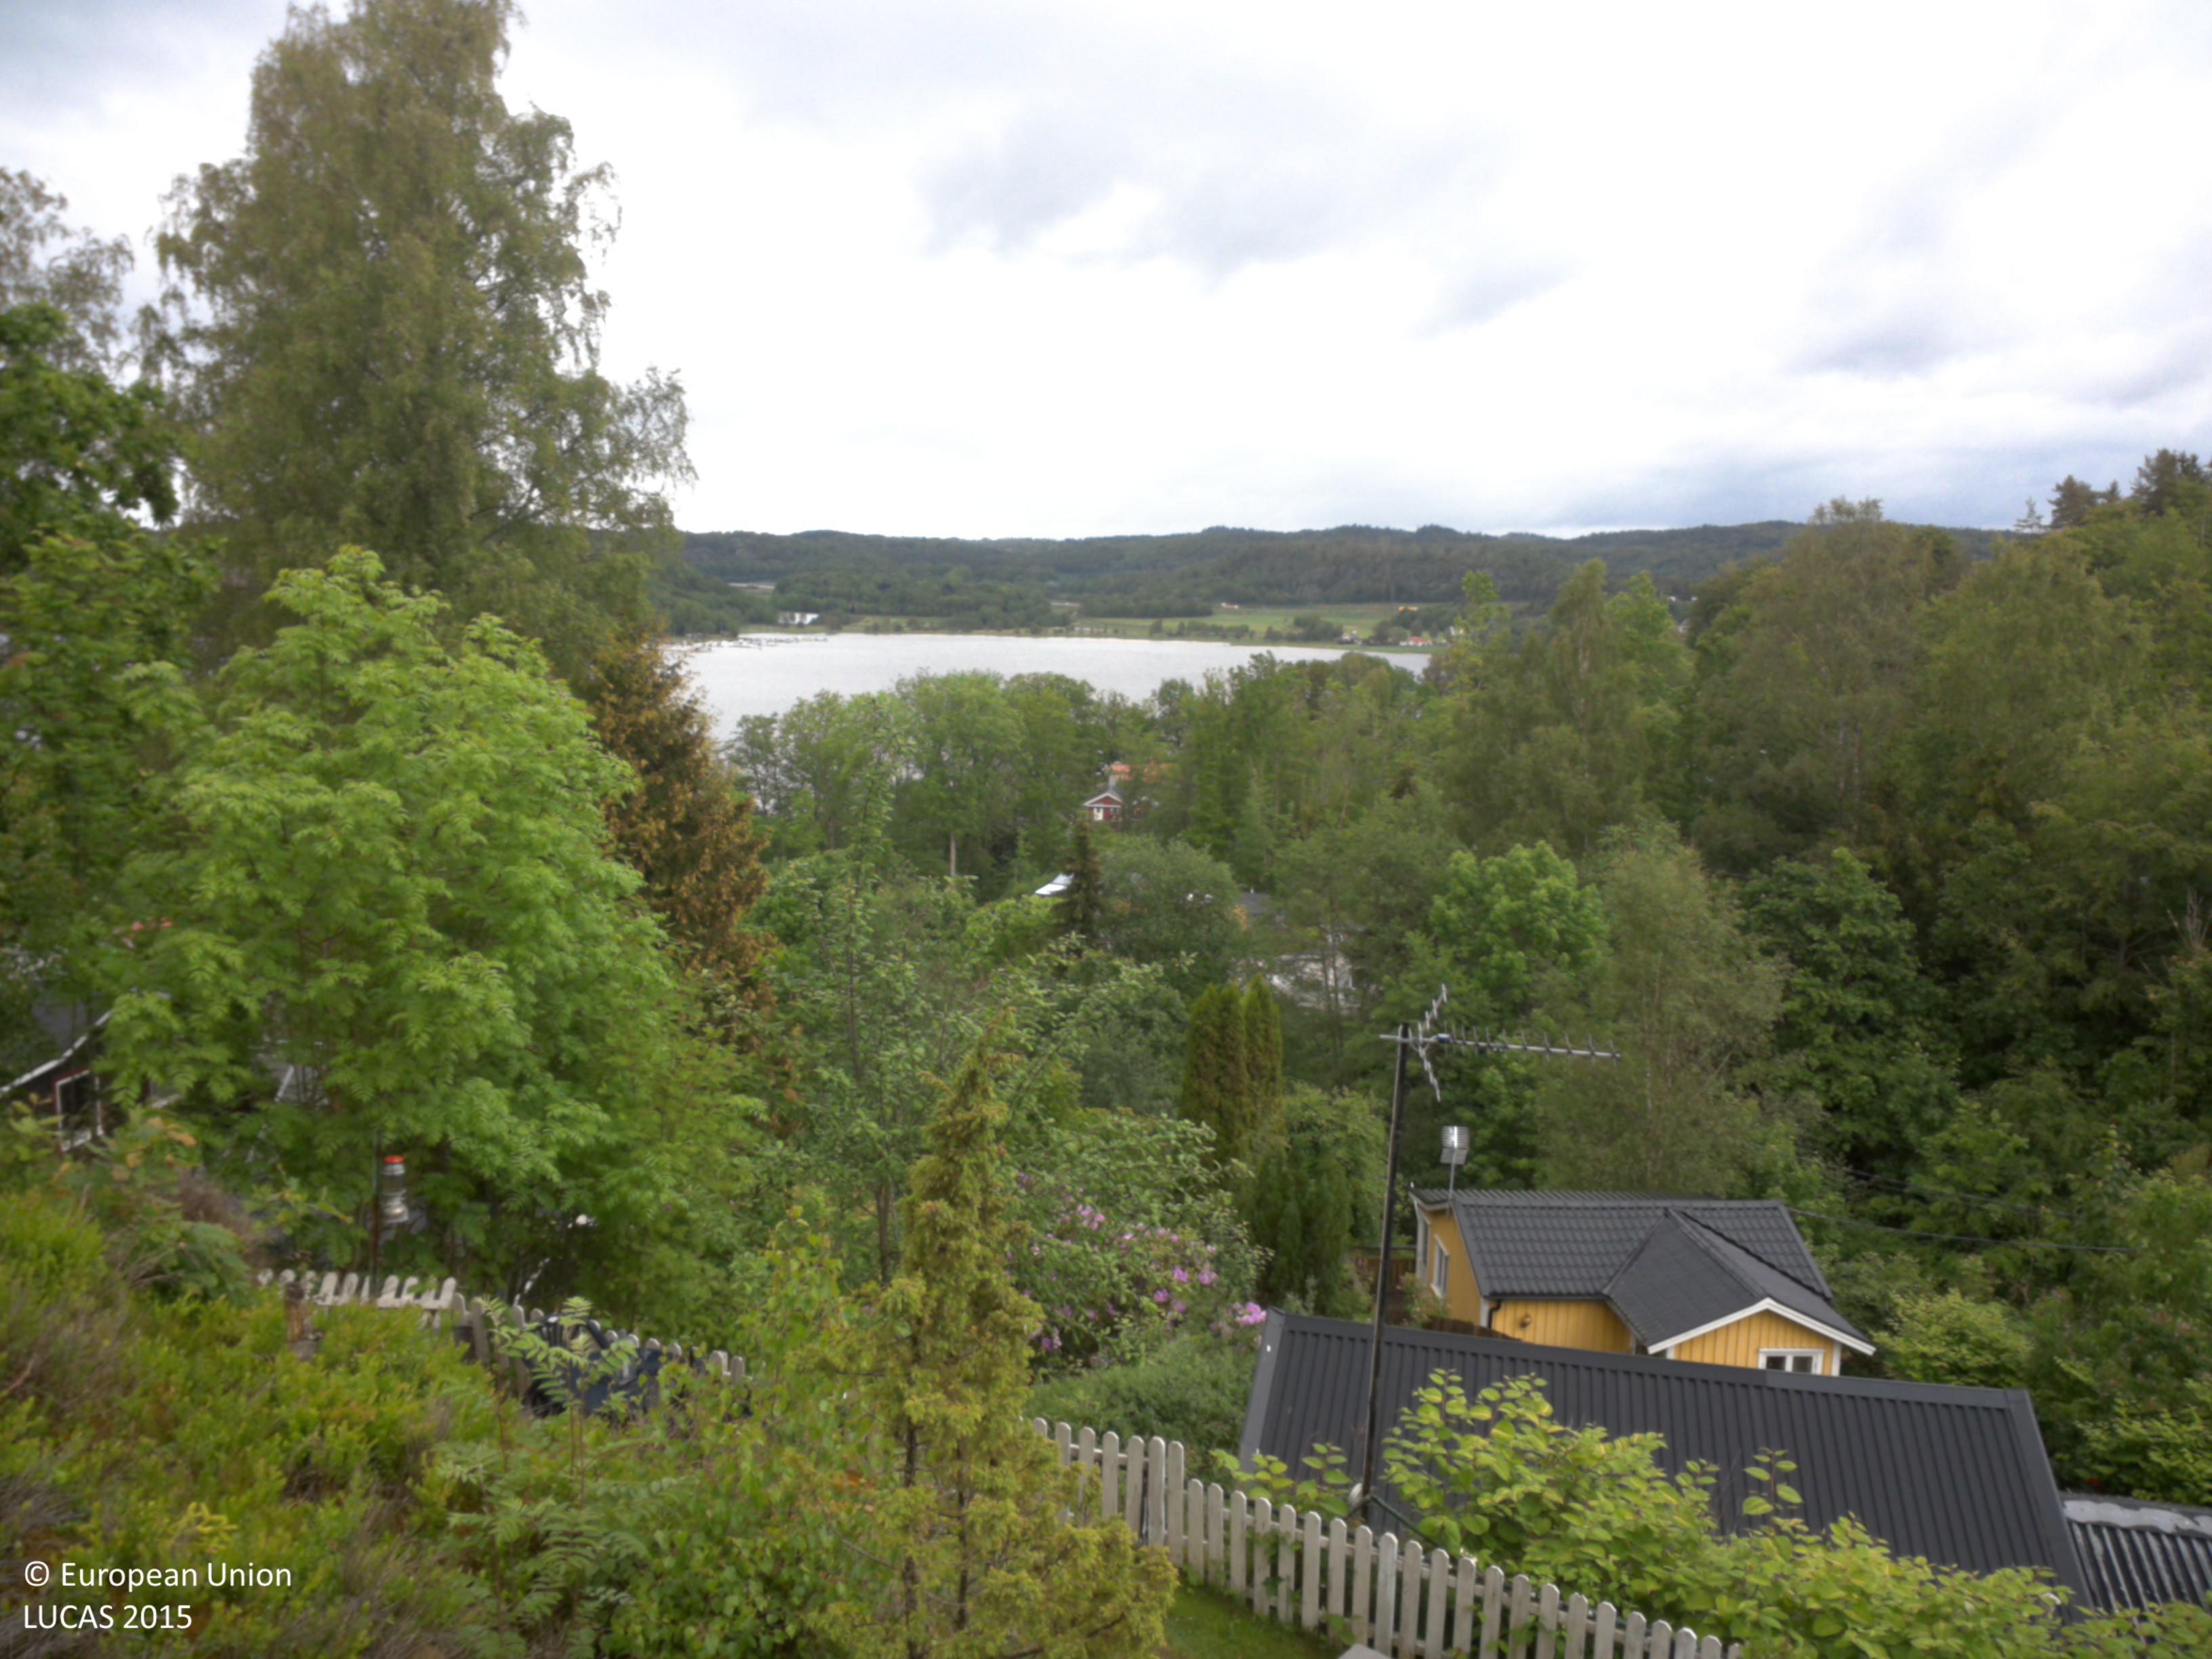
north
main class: Woodland
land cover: Pine dominated coniferous woodland
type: boreal forest
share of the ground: < 10 %
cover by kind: shrubs 80 %, coniferous forest trees 10 %, herbaceous plants 5 %, lichens and mosses 5 %
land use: Amenities, museums, leisure
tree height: > 5 m
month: June
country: SE
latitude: 58.4247
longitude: 11.6916
